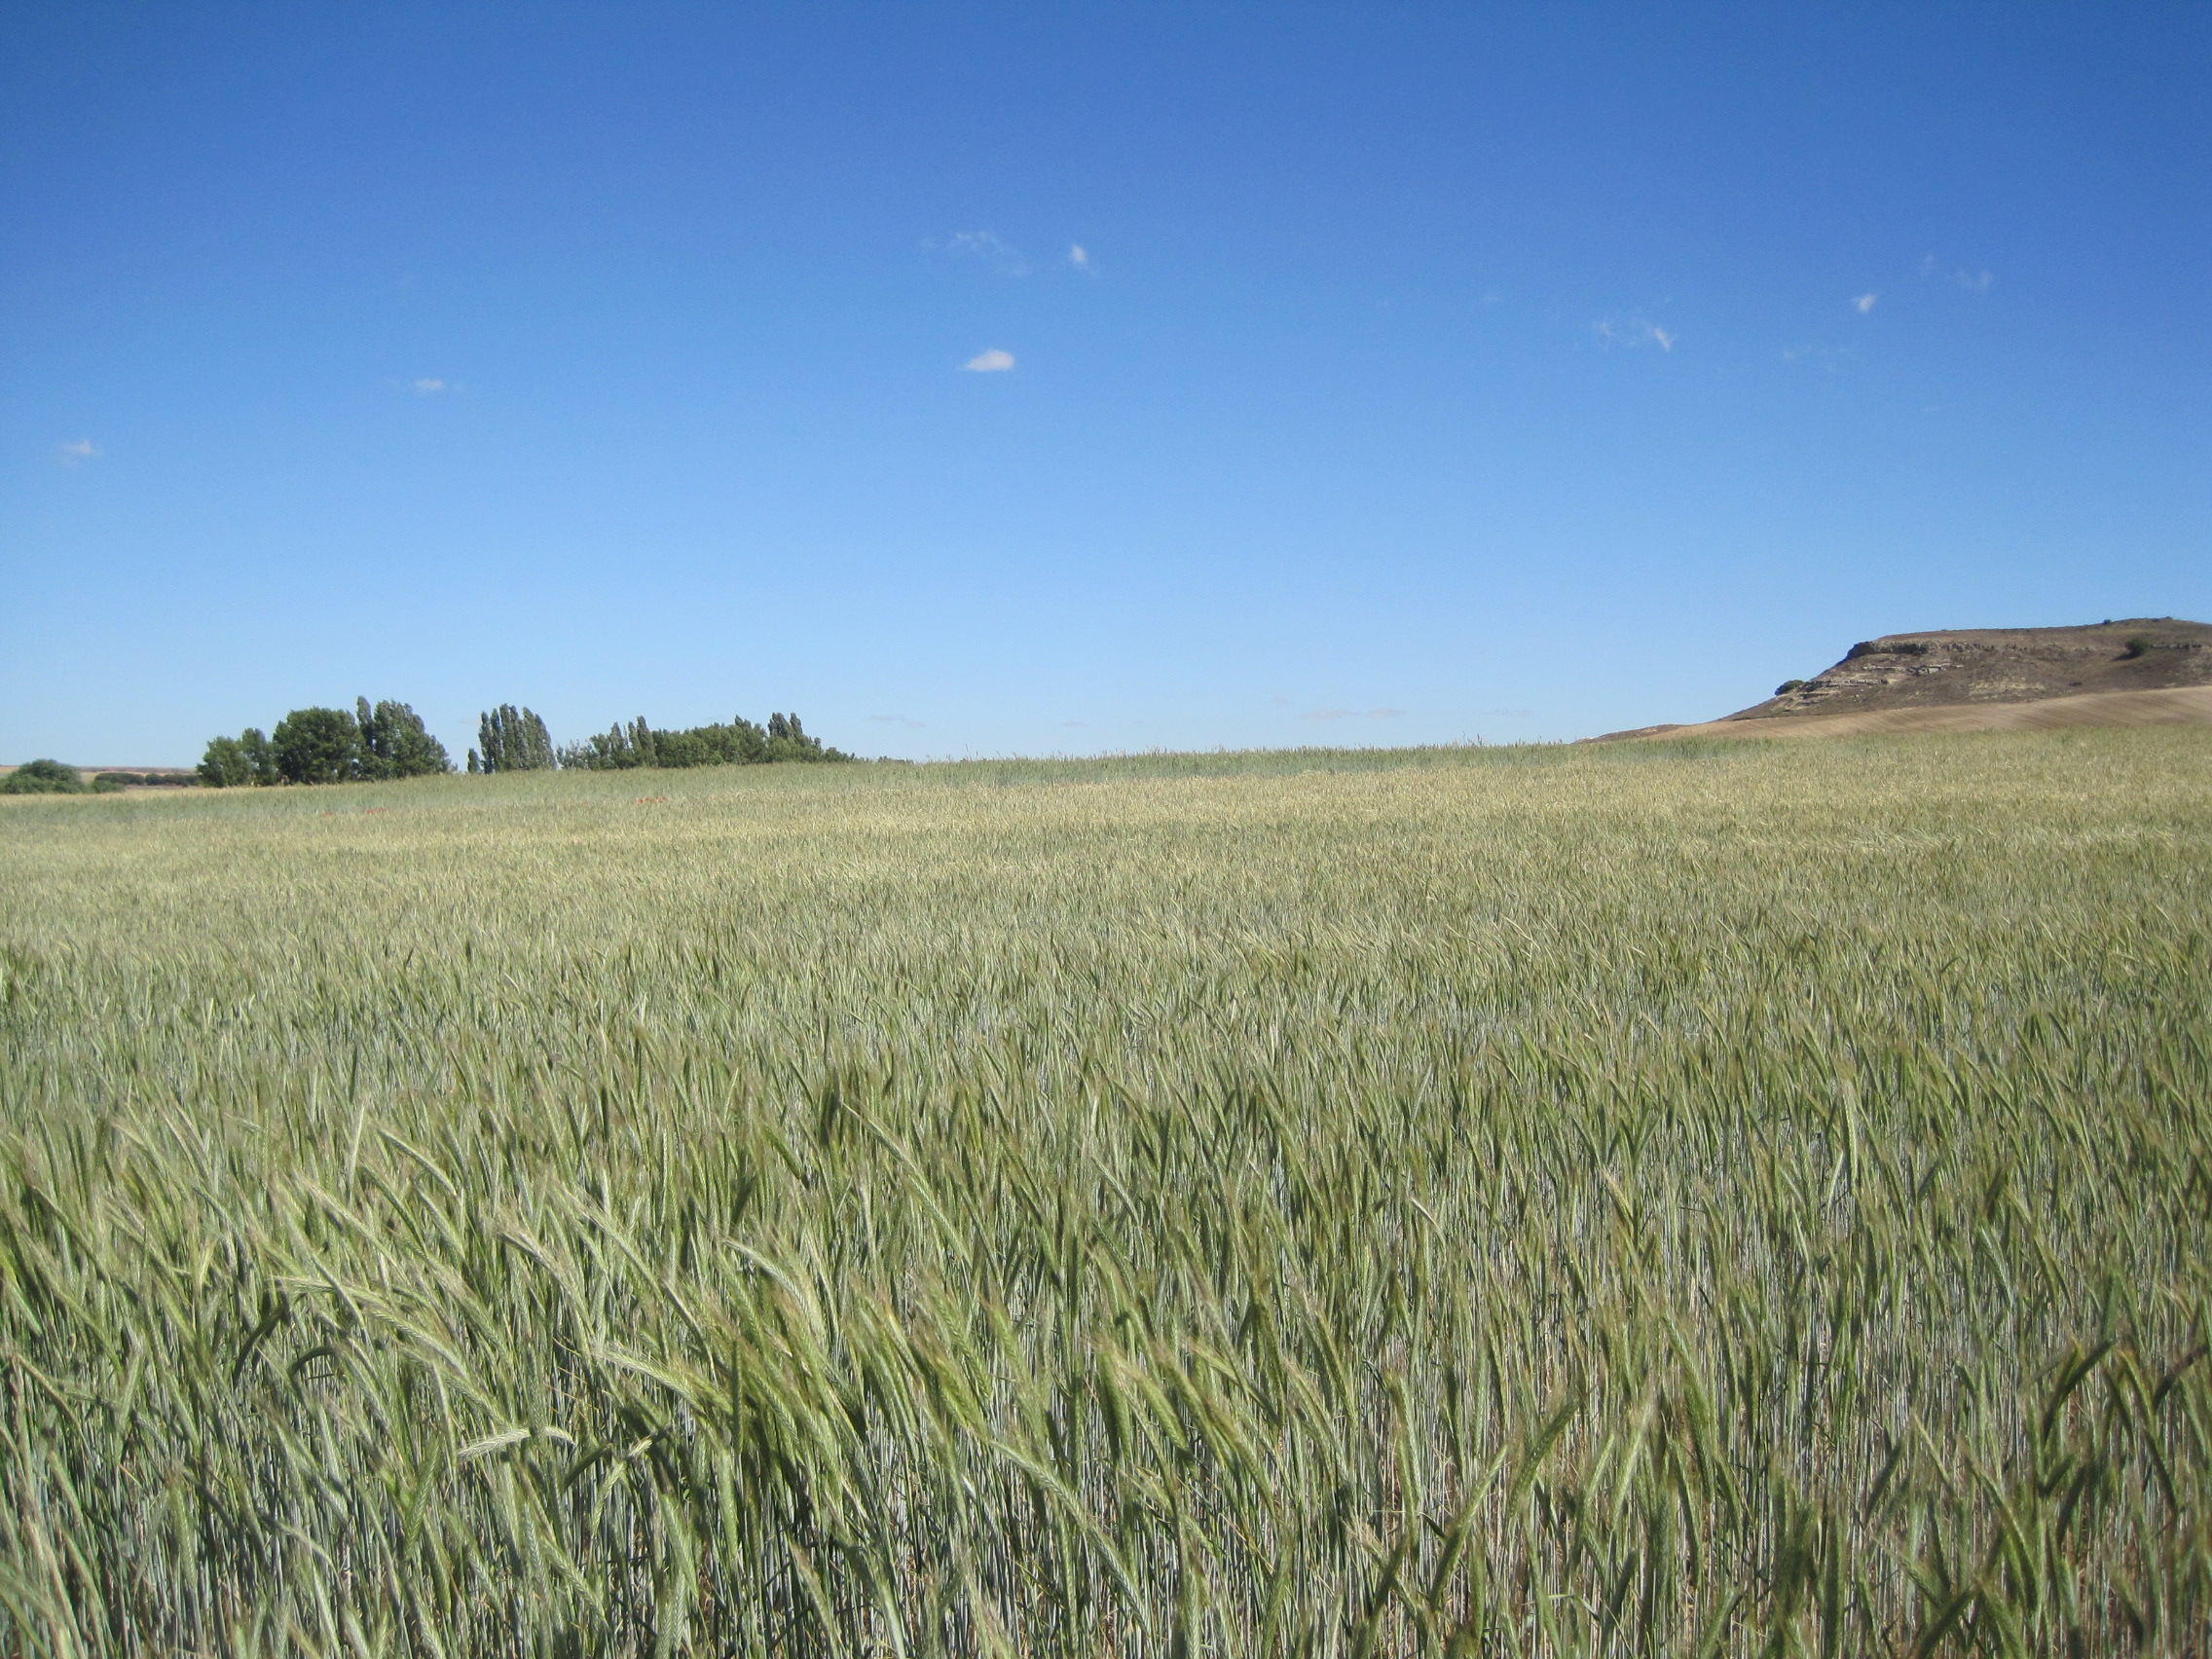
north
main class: Cropland
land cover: Rye
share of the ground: > 75 %
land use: Agriculture (excluding fallow land and kitchen gardens)
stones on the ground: < 10 %
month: May
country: ES
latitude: 41.1725
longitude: -5.2944
